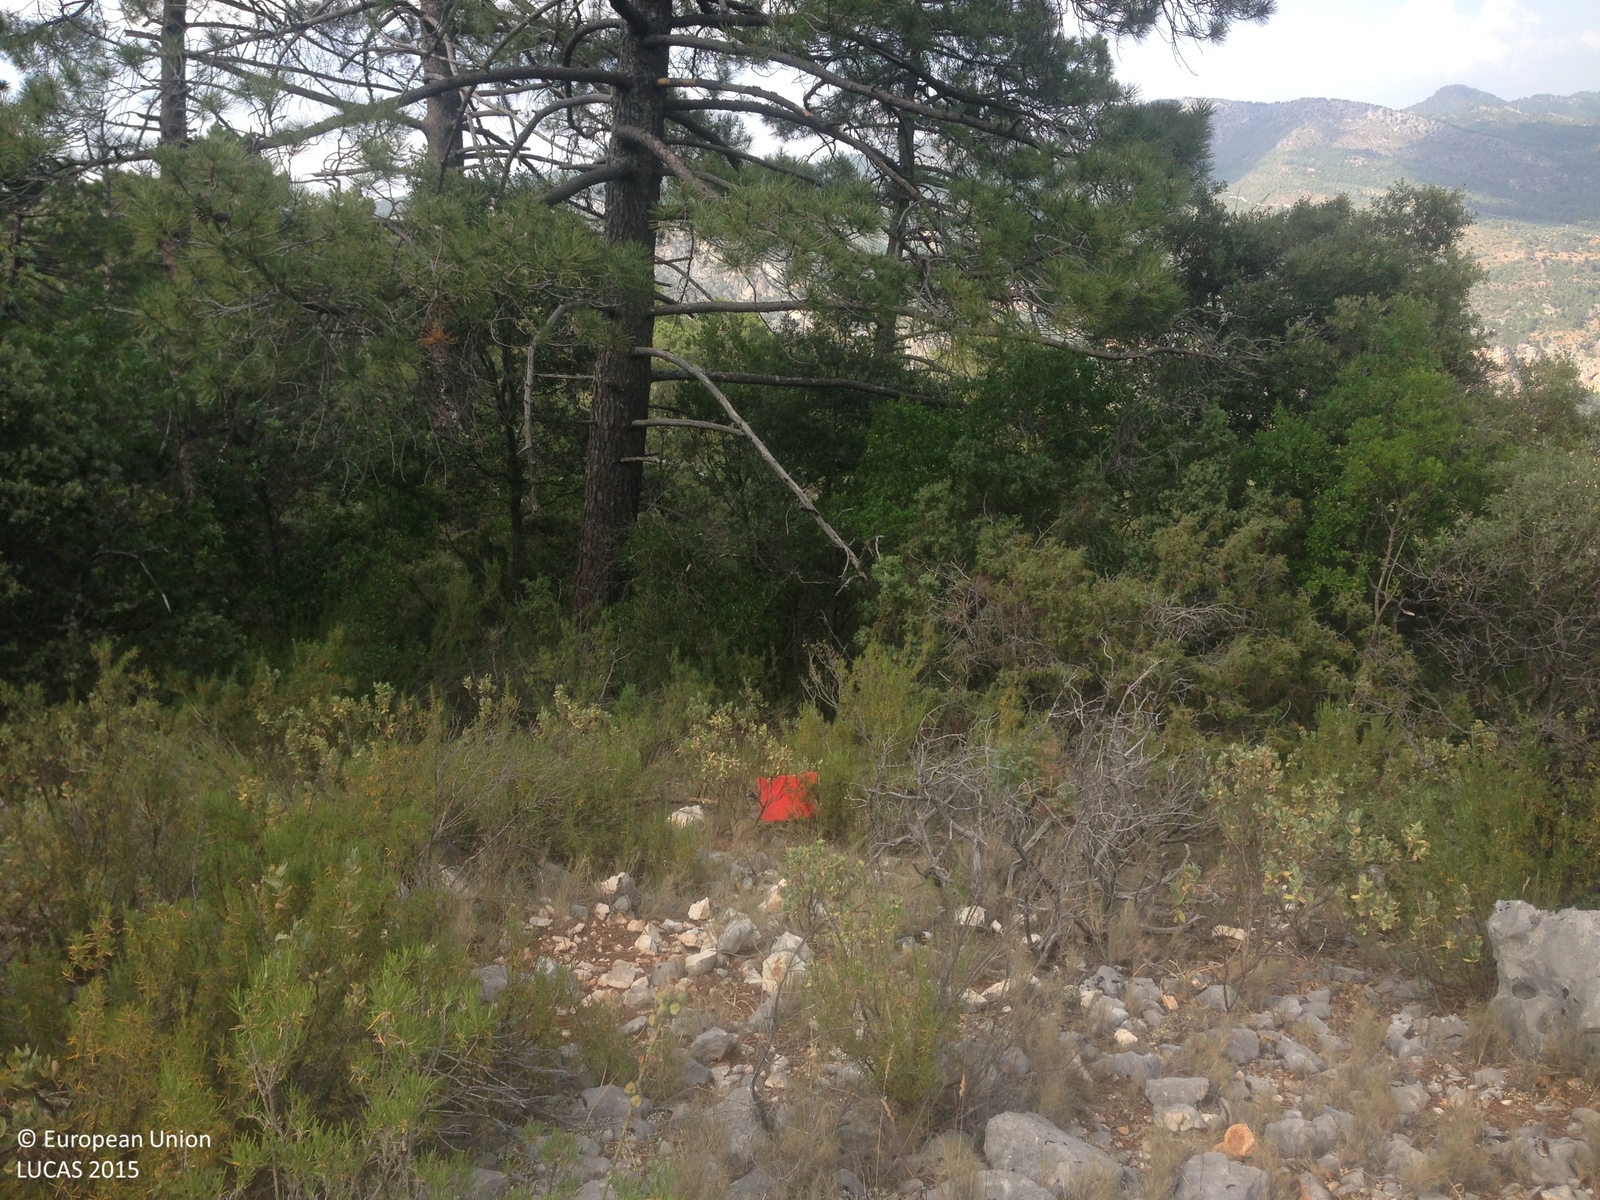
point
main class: Woodland
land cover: Pine dominated coniferous woodland
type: coniferous forest of the mediterranean region
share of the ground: 50 - 75 %
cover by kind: coniferous forest trees 60 %, shrubs 30 %, unconsolidated bare surface 10 %
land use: Forestry
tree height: > 5 m
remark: Clear cut
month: June
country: ES
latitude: 38.1718
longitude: -2.8620
